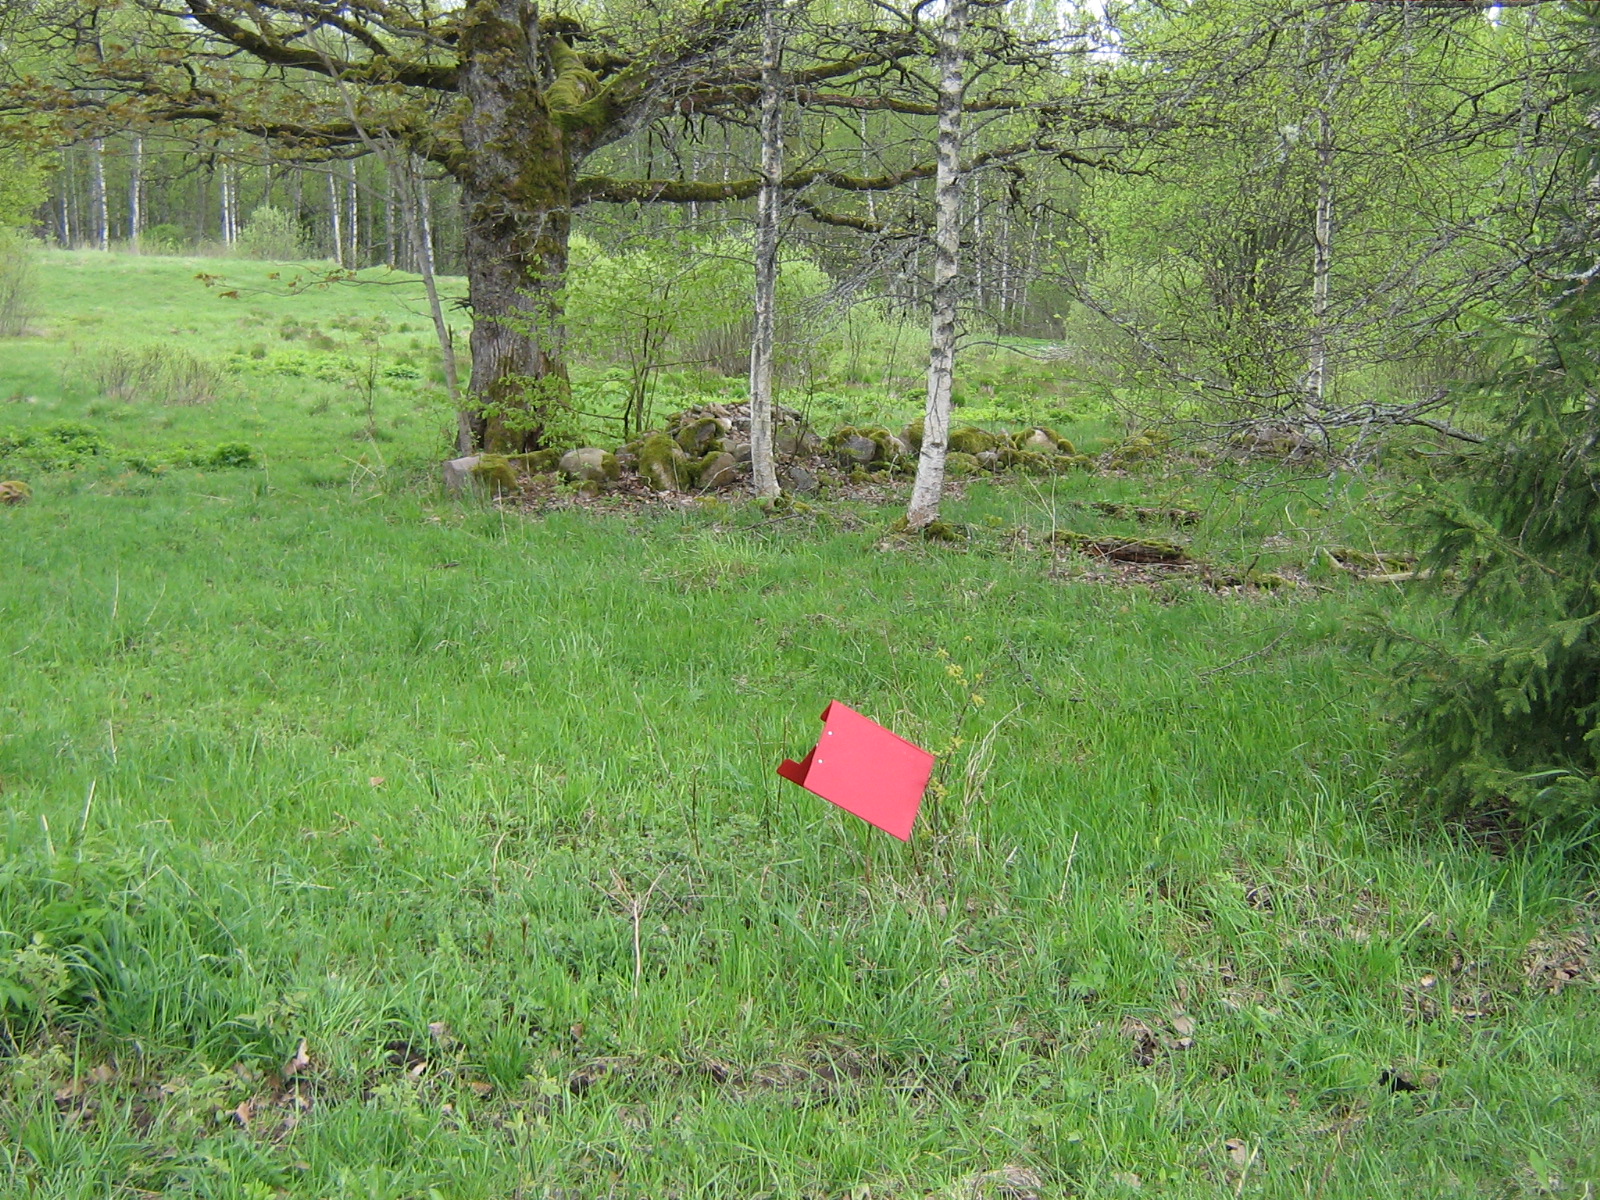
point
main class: Woodland
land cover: Spruce dominated mixed woodland
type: hemiboreal forest and nemoral coniferous forest and mixed broadleaved-coniferous forest
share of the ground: > 75 %
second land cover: Grassland without tree/shrub cover
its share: > 75 %
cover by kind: broadleaved forest trees 55 %, coniferous forest trees 30 %, herbaceous plants 15 %
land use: Agriculture (excluding fallow land and kitchen gardens)
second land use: Forestry
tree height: > 5 m
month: May
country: LV
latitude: 57.1111
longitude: 25.4895
